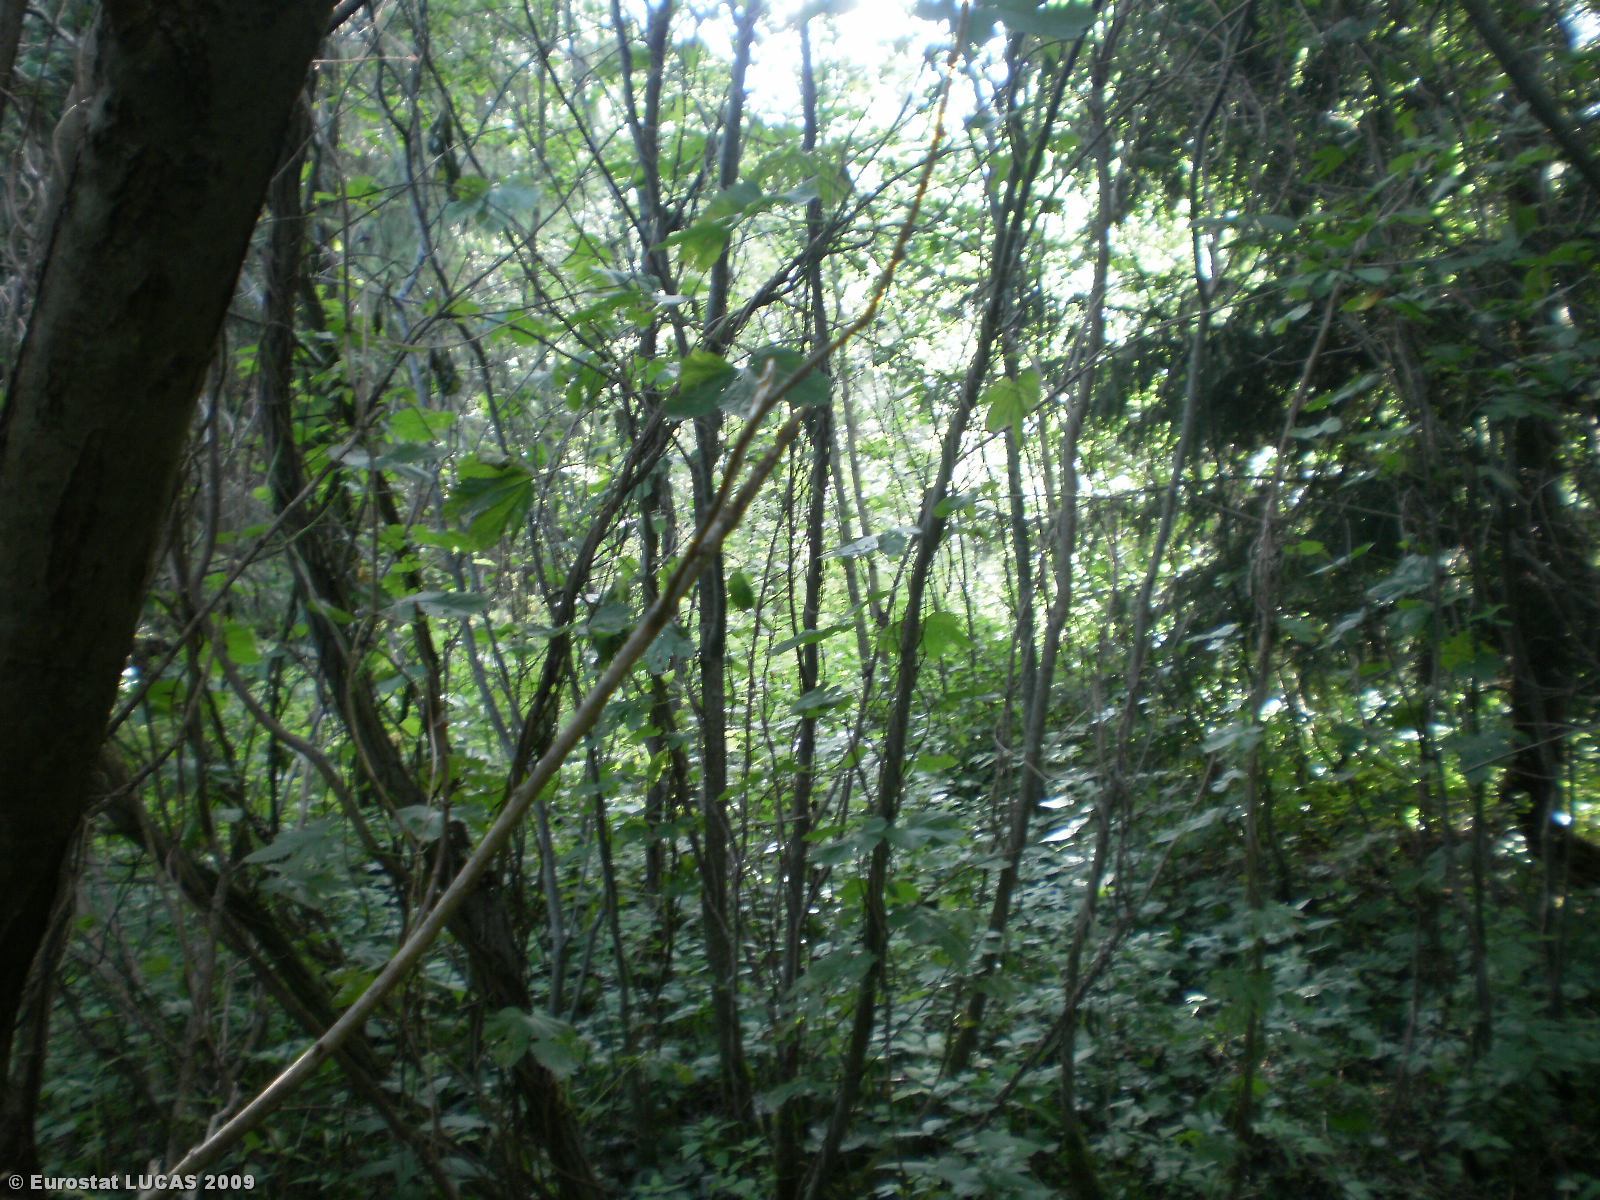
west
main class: Woodland
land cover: Broadleaved woodland
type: non-riverine alder, birch or aspen forest
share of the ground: 50 - 75 %
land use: Forestry
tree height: > 5 m
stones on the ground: < 10 %
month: July
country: LT
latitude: 55.8137
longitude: 25.5887
